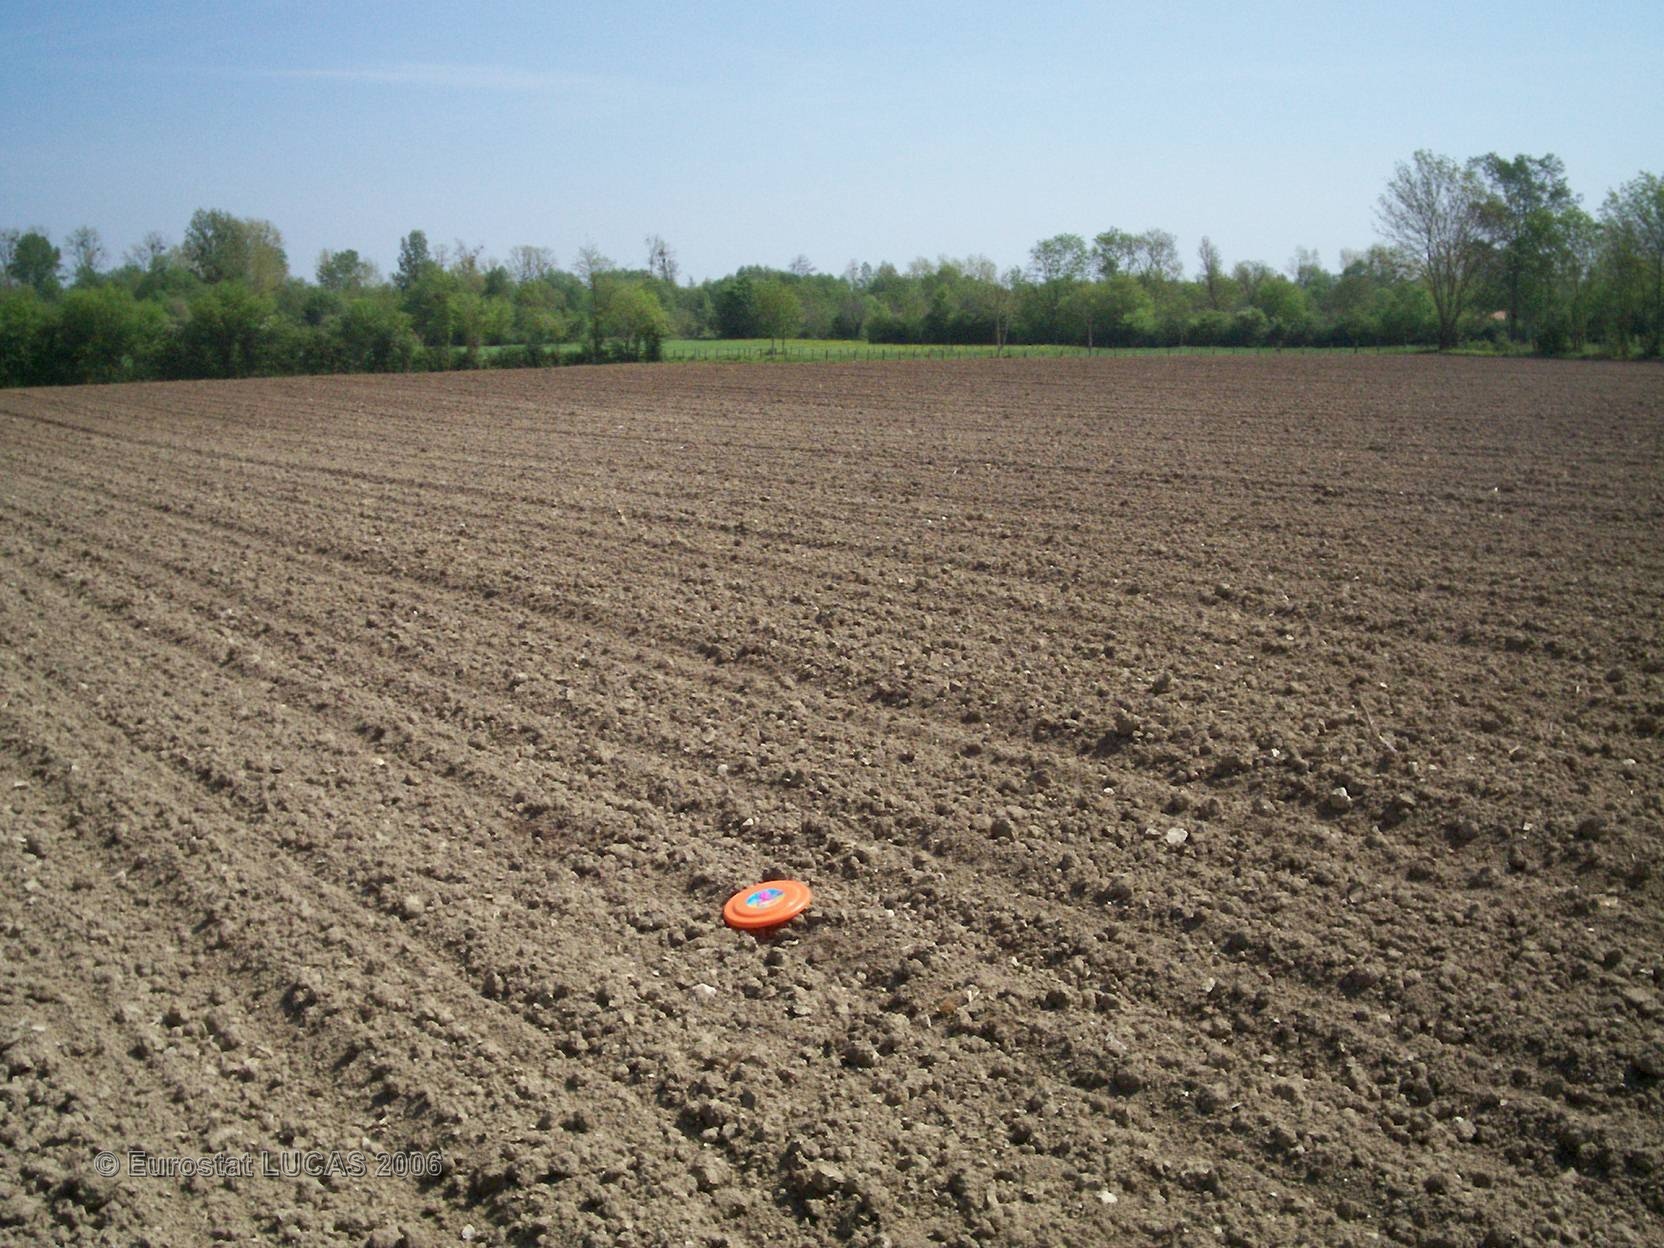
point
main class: Cropland
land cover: Maize
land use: Agriculture (excluding fallow land and kitchen gardens)
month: May
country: FR
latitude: 46.1491
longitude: -0.2377
